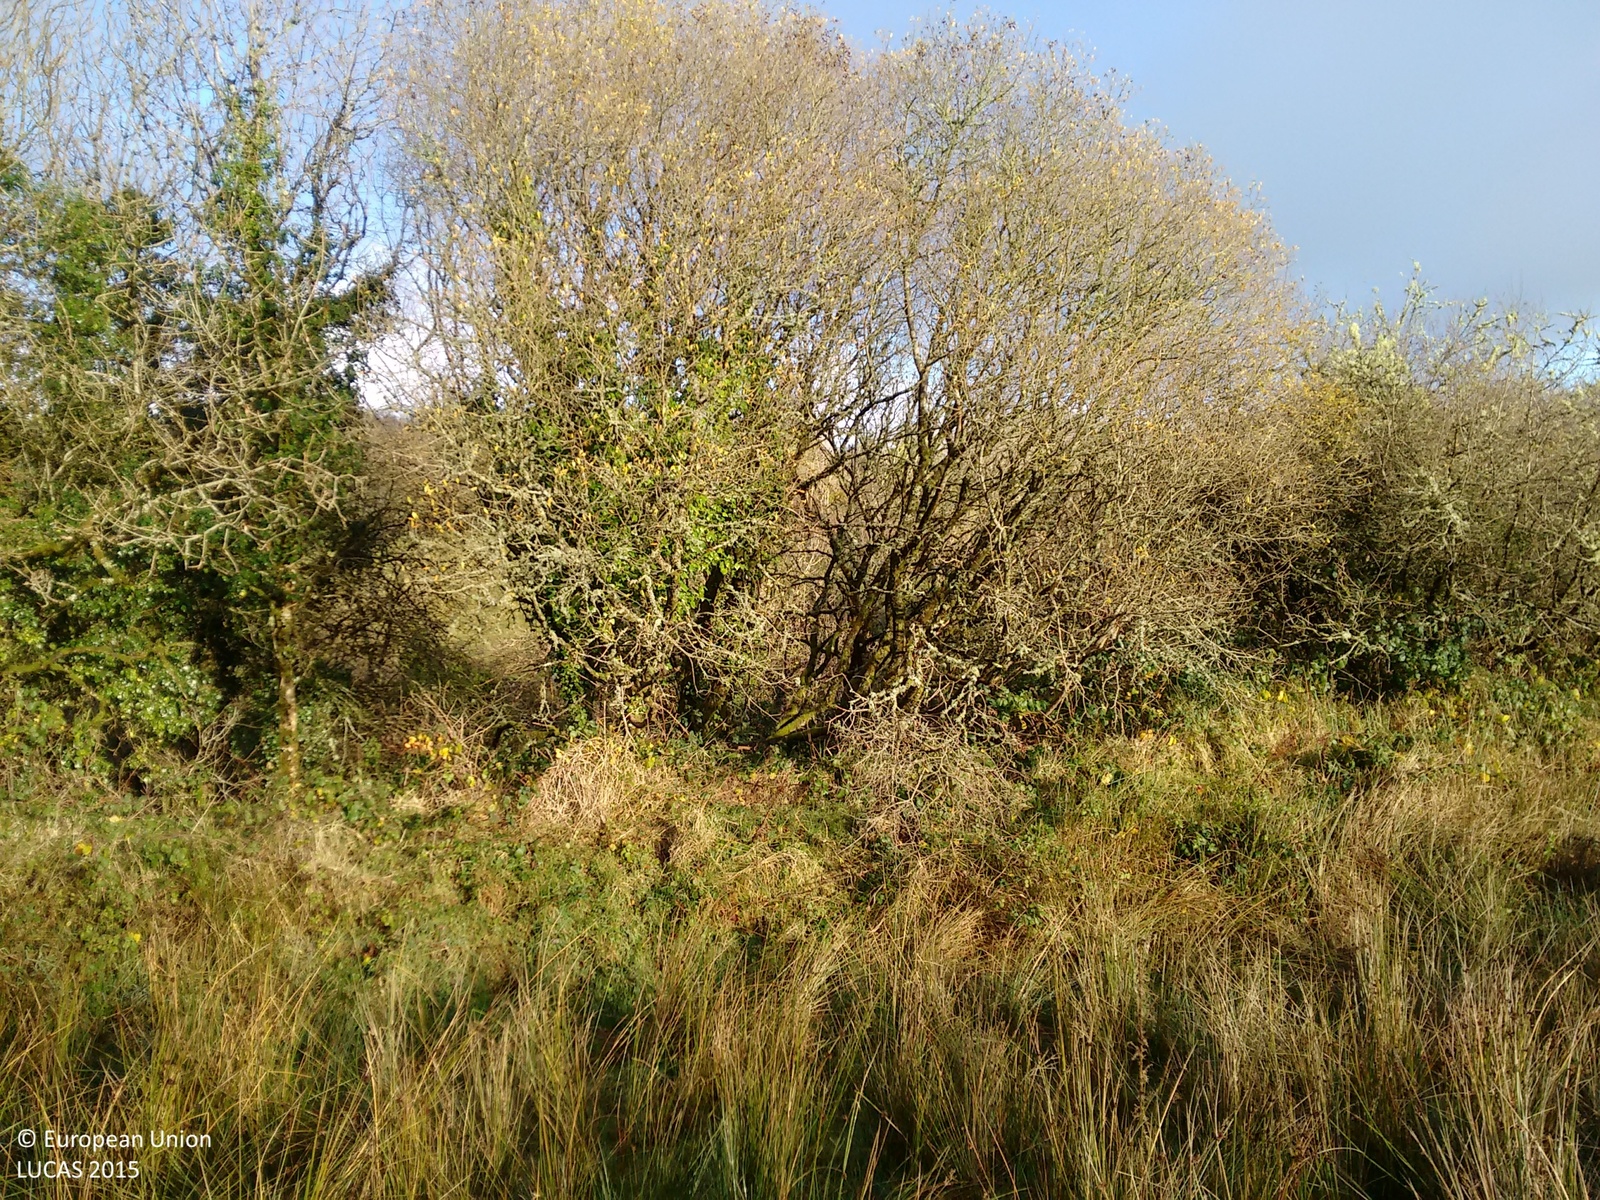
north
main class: Grassland
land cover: Grassland without tree/shrub cover
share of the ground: > 75 %
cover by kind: herbaceous plants 100 %
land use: Agriculture (excluding fallow land and kitchen gardens)
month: November
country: IE
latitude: 54.0663
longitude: -7.8793
